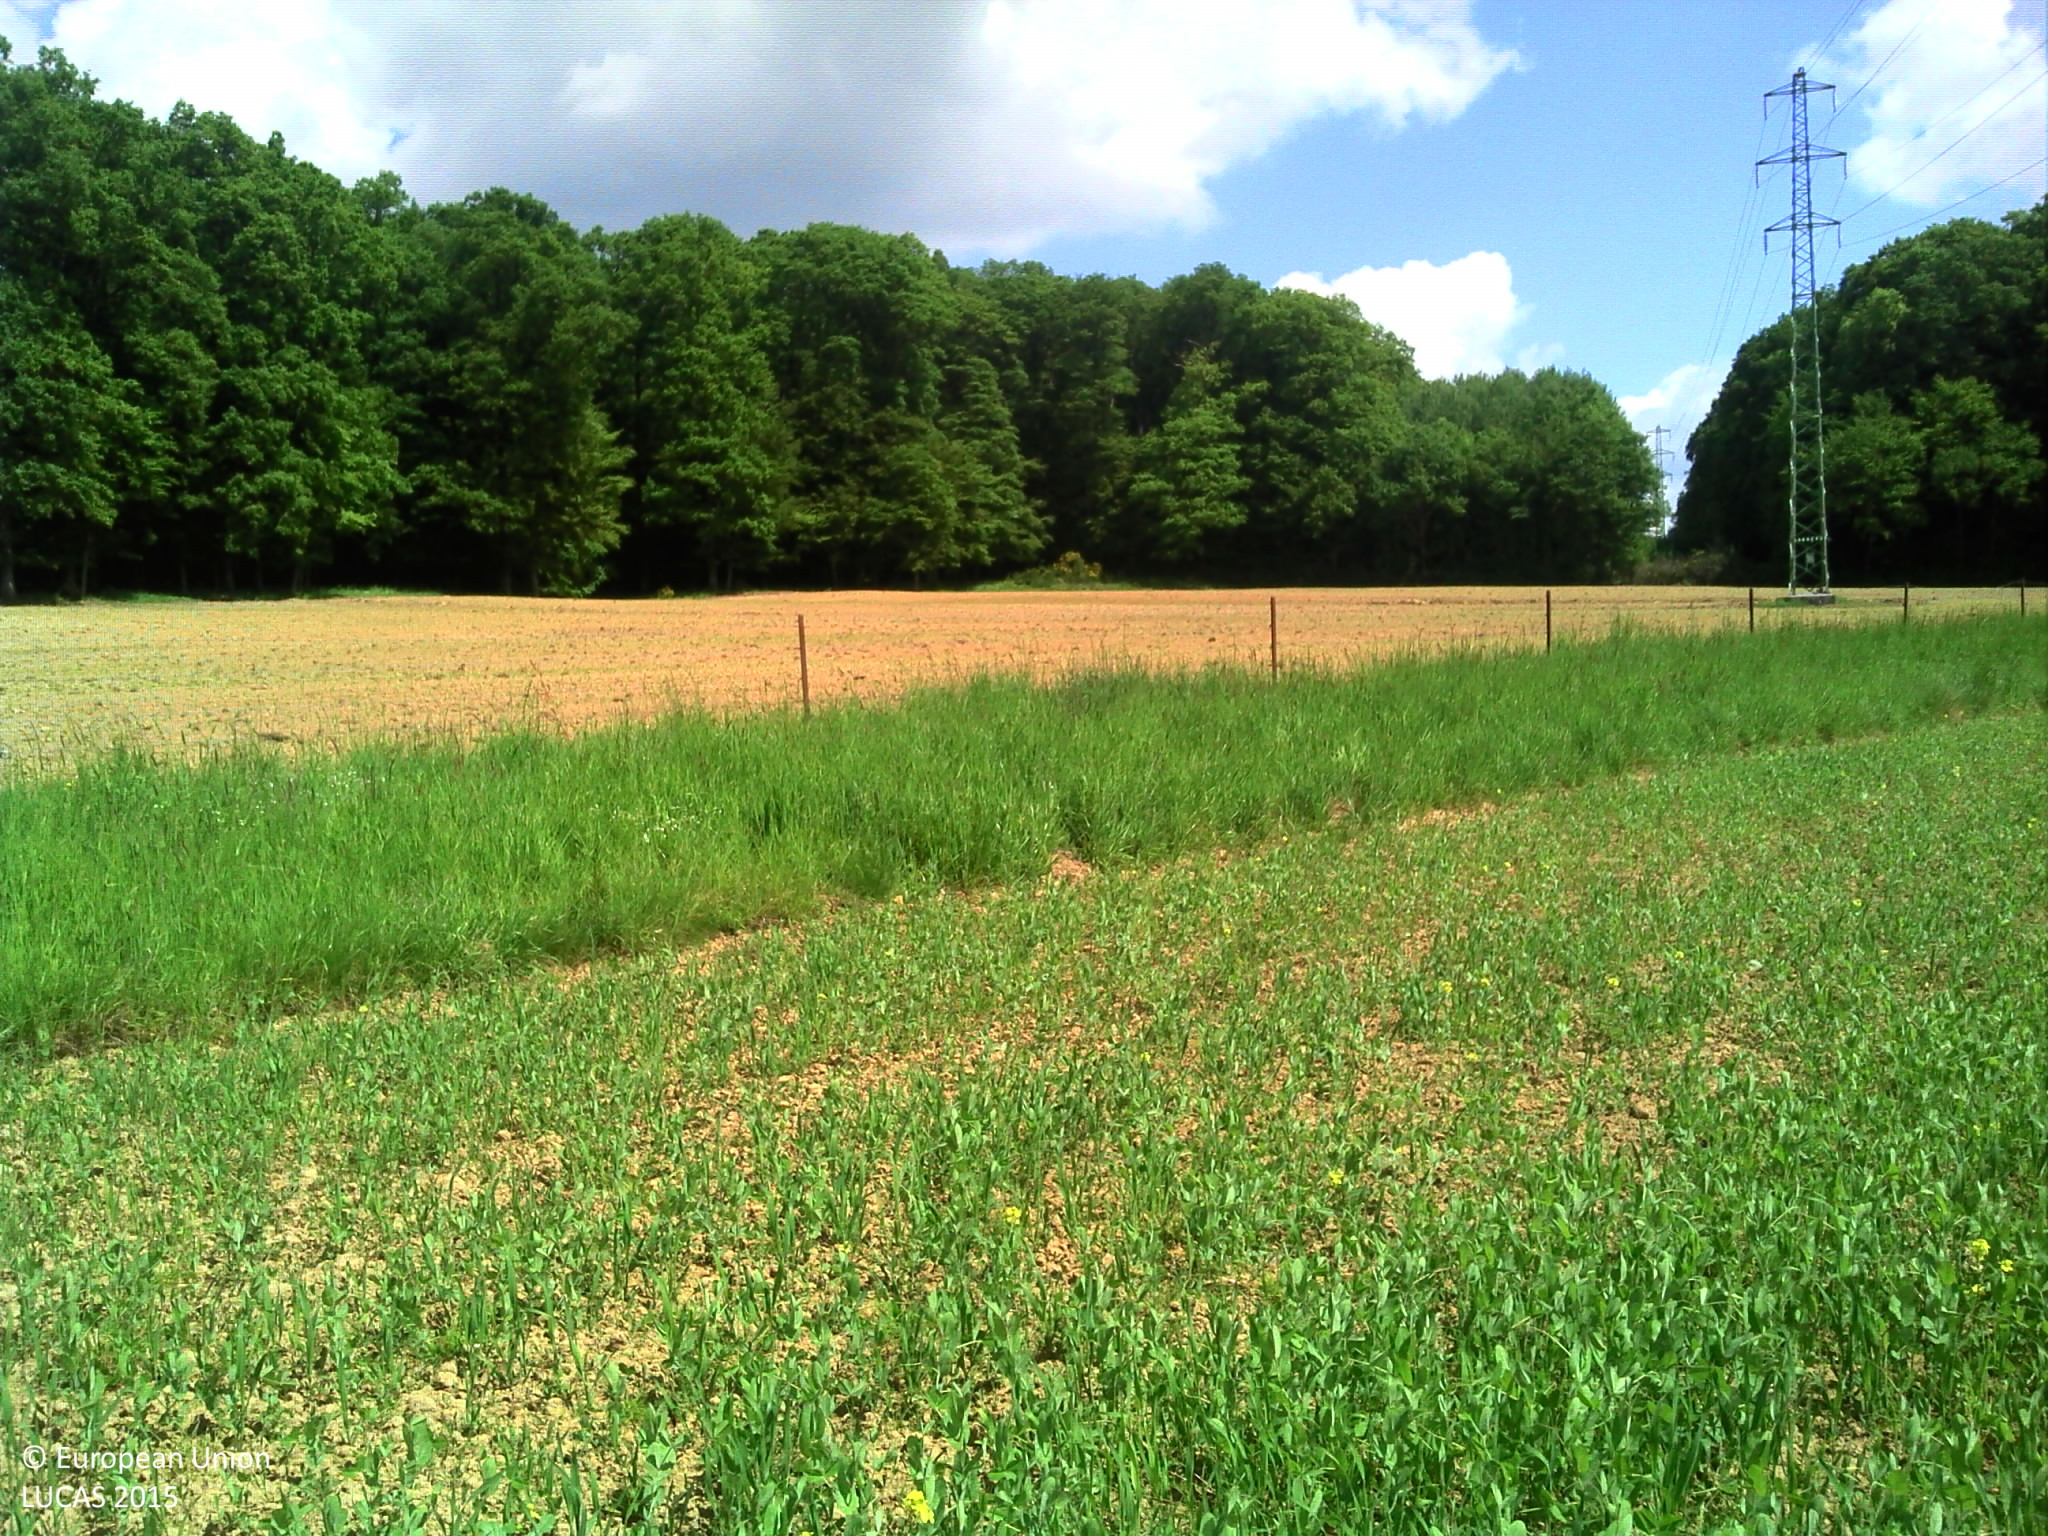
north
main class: Cropland
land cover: Other leguminous and mixtures for fodder
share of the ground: > 75 %
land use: Agriculture (excluding fallow land and kitchen gardens)
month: May
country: LU
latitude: 49.5570
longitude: 6.0318
